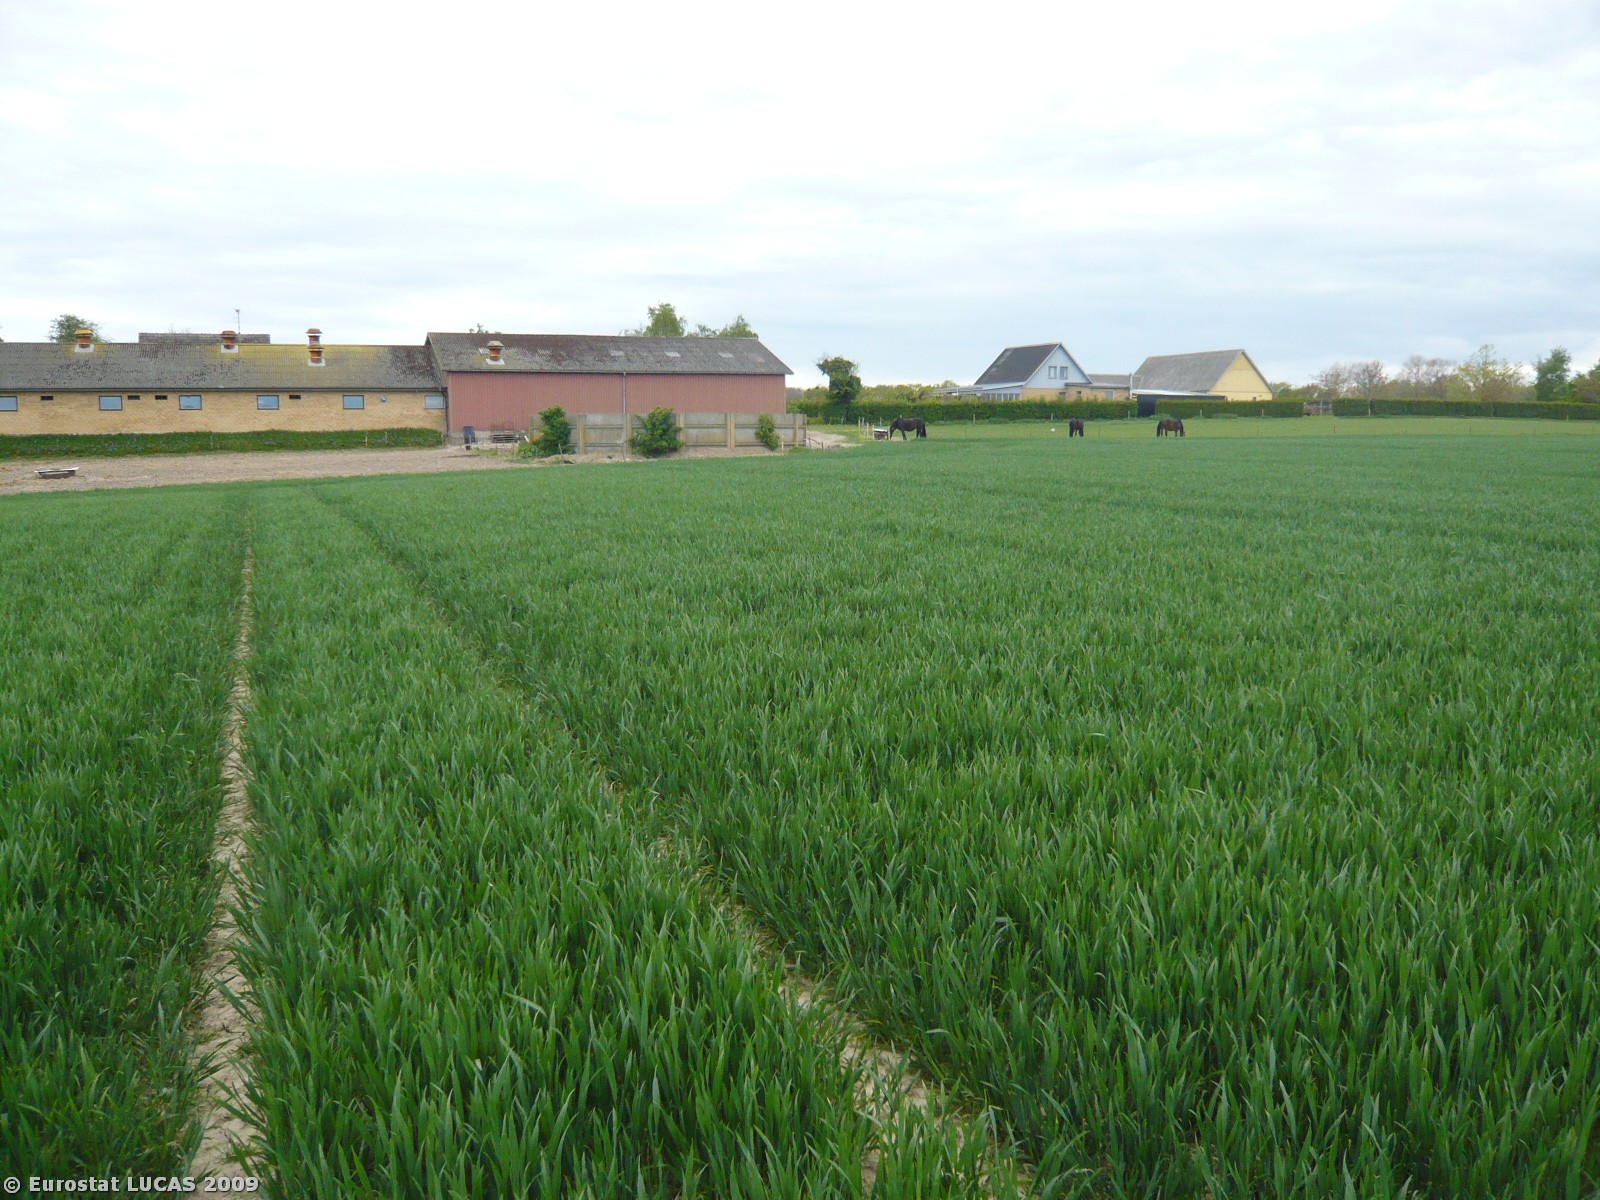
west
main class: Cropland
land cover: Common wheat
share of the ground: > 75 %
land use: Agriculture (excluding fallow land and kitchen gardens)
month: May
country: DK
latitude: 55.1125
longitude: 11.9269
